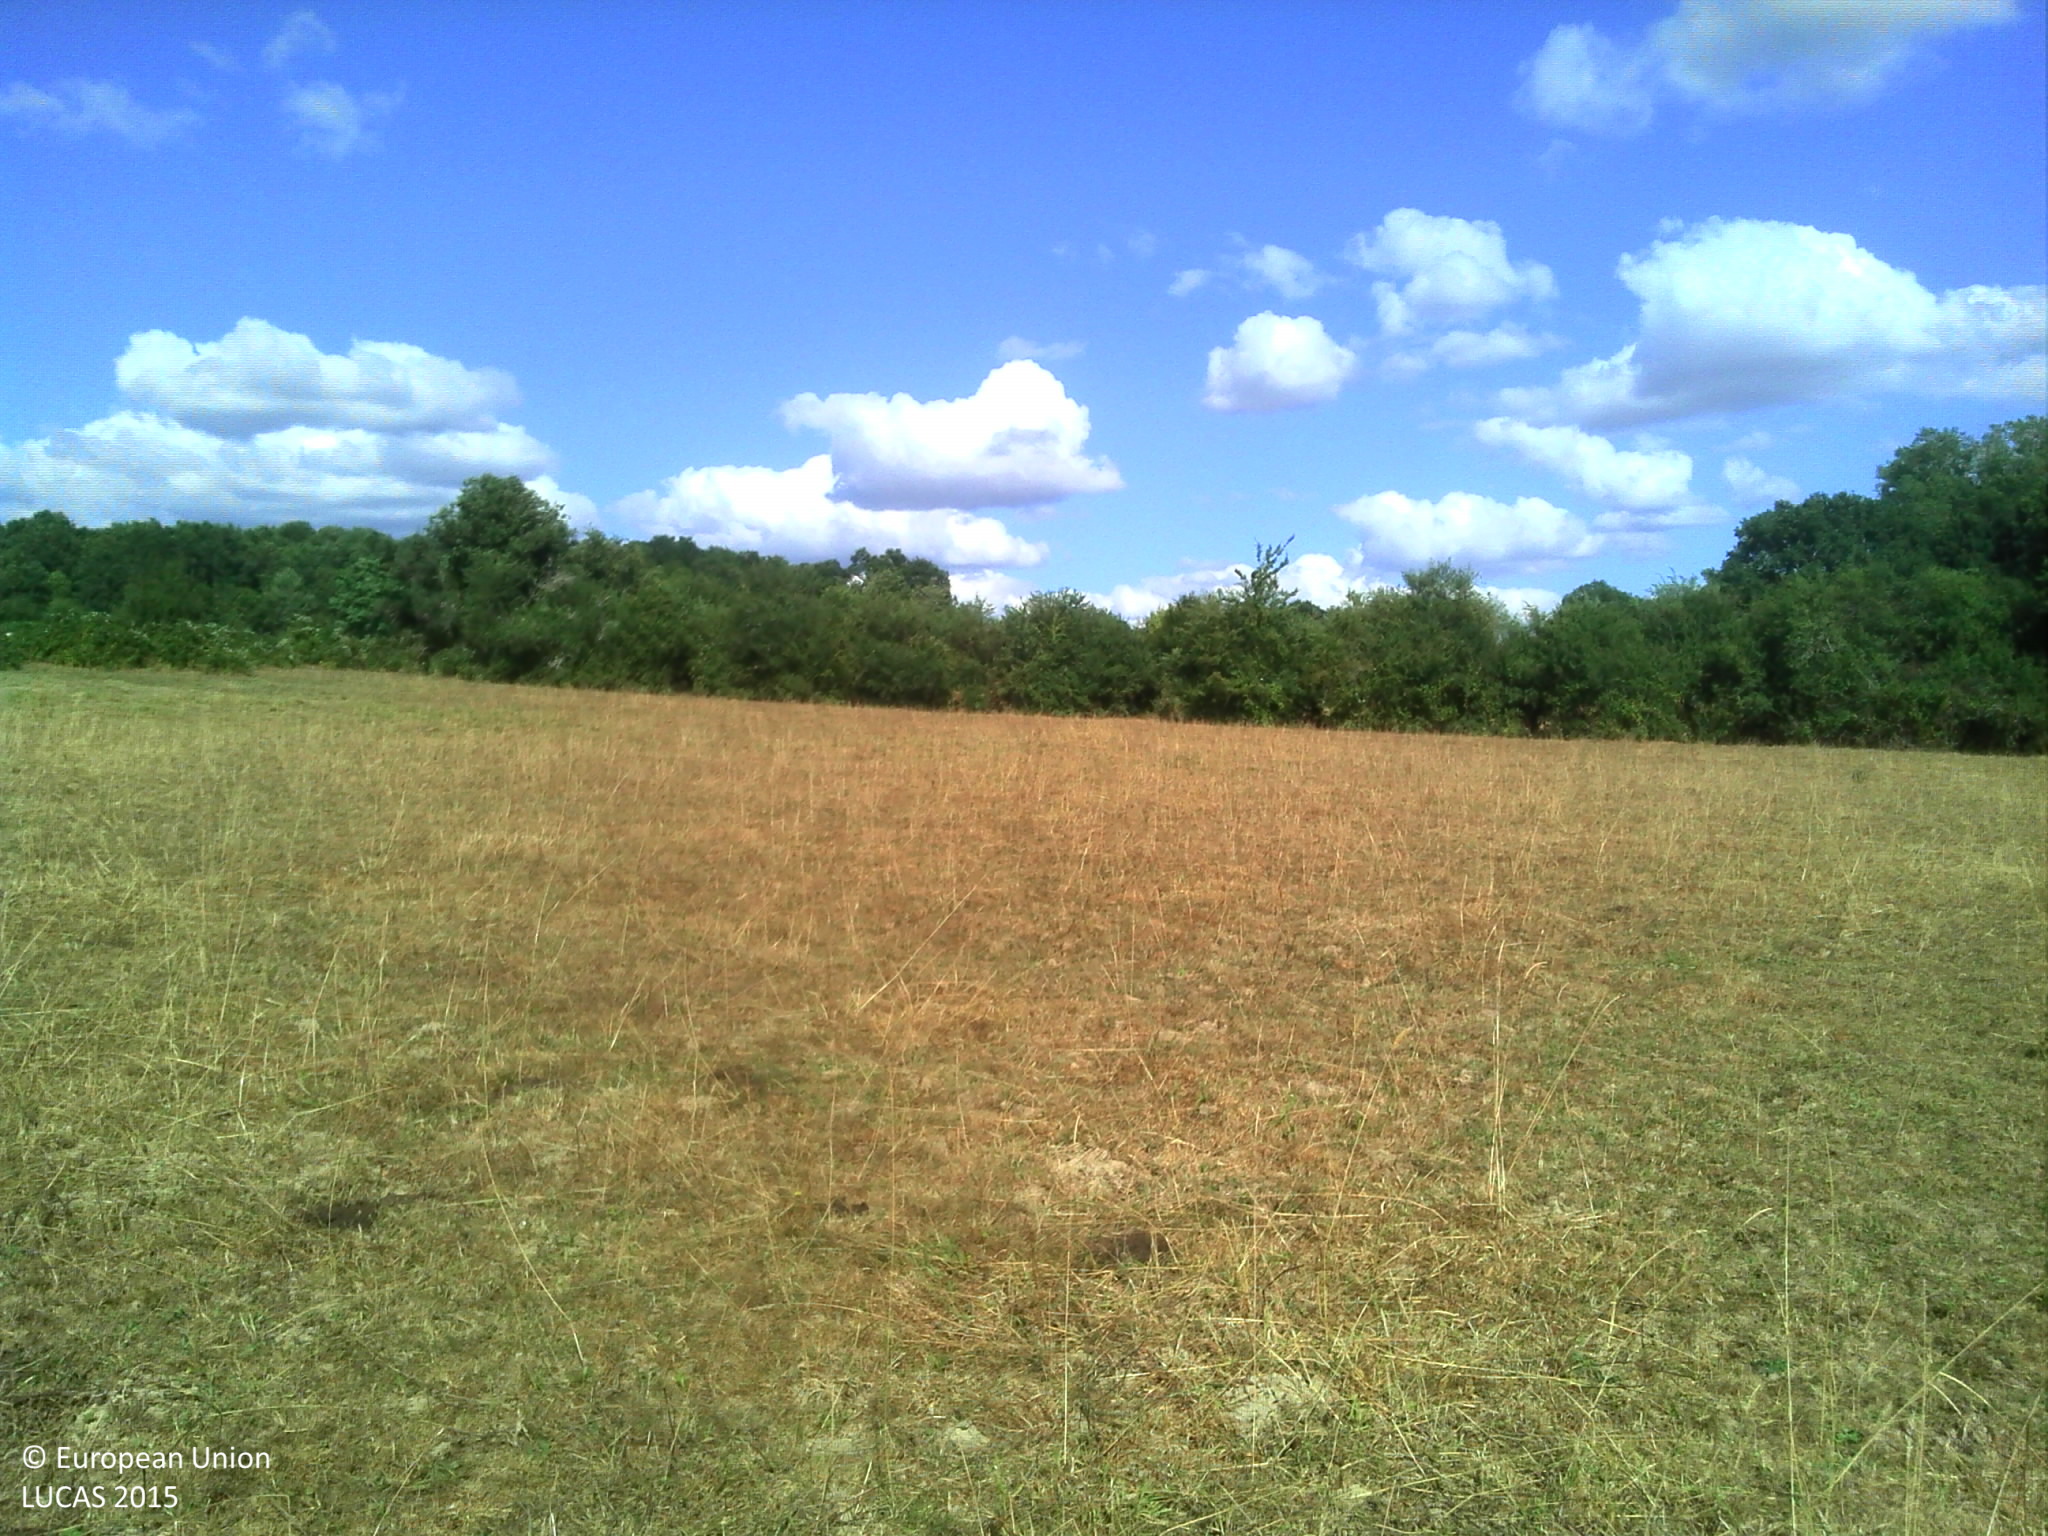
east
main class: Grassland
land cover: Grassland without tree/shrub cover
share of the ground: > 75 %
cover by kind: herbaceous plants 100 %
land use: Agriculture (excluding fallow land and kitchen gardens)
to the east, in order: Grassland without tree/shrub cover; Abandoned hedges; Grassland without tree/shrub cover; Fences; Broadleaved woodland; Fences; Grassland without tree/shrub cover; Spontaneously vegetated surfaces
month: July
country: FR
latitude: 47.0033
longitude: 4.4895
